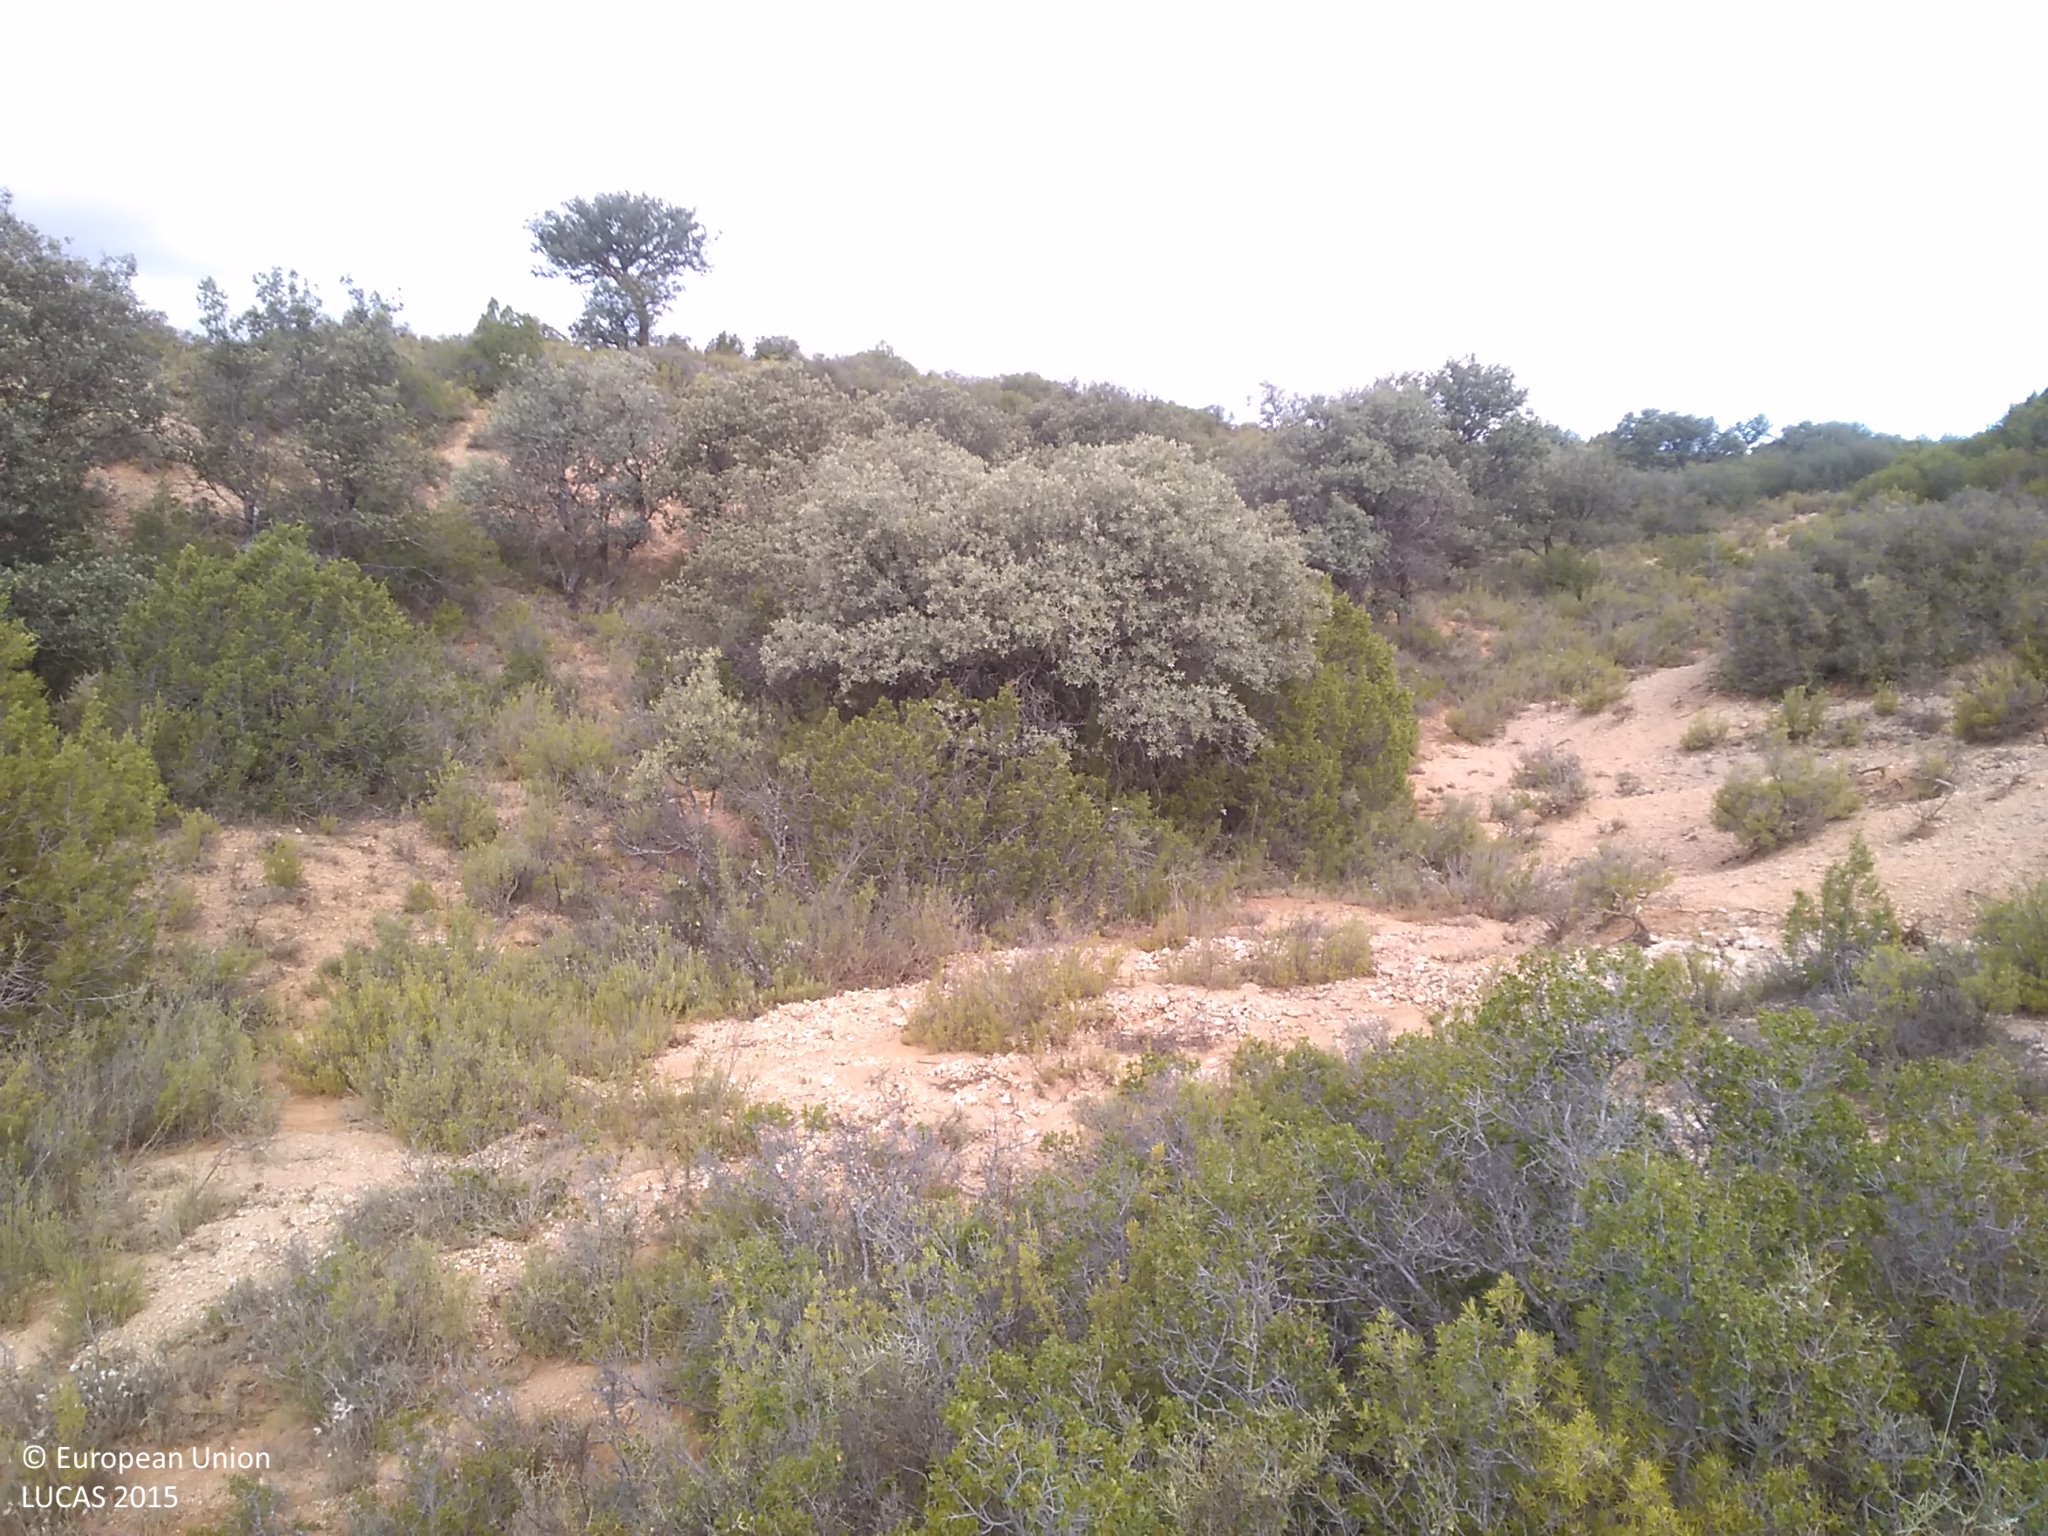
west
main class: Woodland
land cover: Other mixed woodland
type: coniferous forest of the mediterranean region
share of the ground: 25 - 50 %
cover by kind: shrubs 30 %, unconsolidated bare surface 25 %, coniferous forest trees 20 %, broadleaved forest trees 20 %, herbaceous plants 5 %
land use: Semi-natural and natural areas not in use
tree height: < 5 m
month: July
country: ES
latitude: 41.3548
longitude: -1.9934
